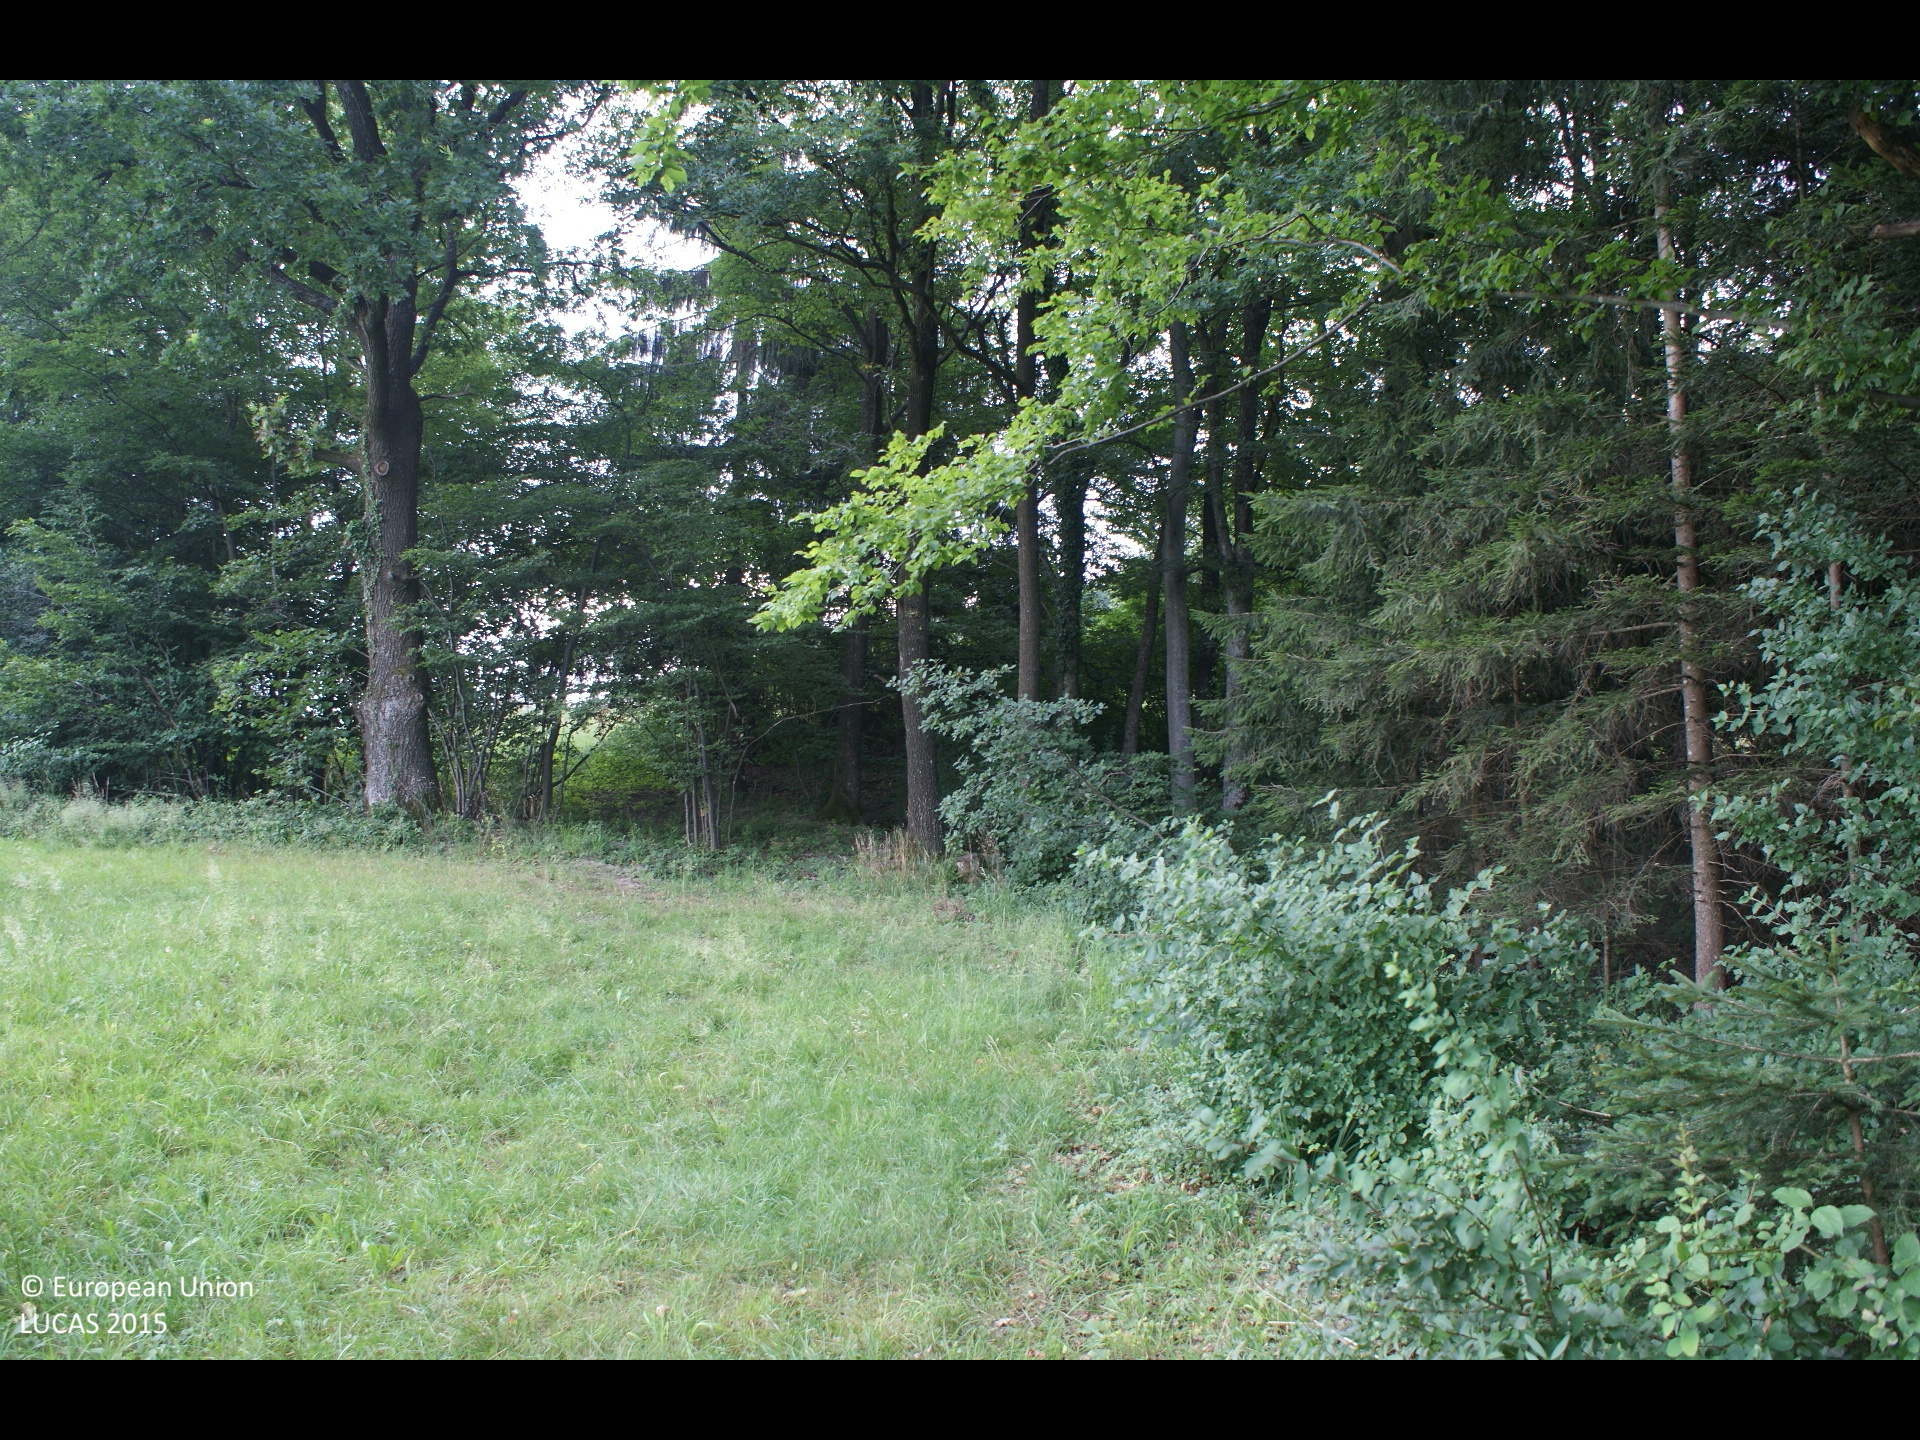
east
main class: Grassland
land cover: Grassland without tree/shrub cover
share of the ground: > 75 %
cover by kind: herbaceous plants 100 %
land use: Agriculture (excluding fallow land and kitchen gardens)
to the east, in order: Grassland without tree/shrub cover; Broadleaved woodland; Shrubland with sparse tree cover; Grassland without tree/shrub cover; Broadleaved woodland; Fences; Broadleaved woodland; Grassland without tree/shrub cover
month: July
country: AT
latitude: 48.0740
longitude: 15.3839
